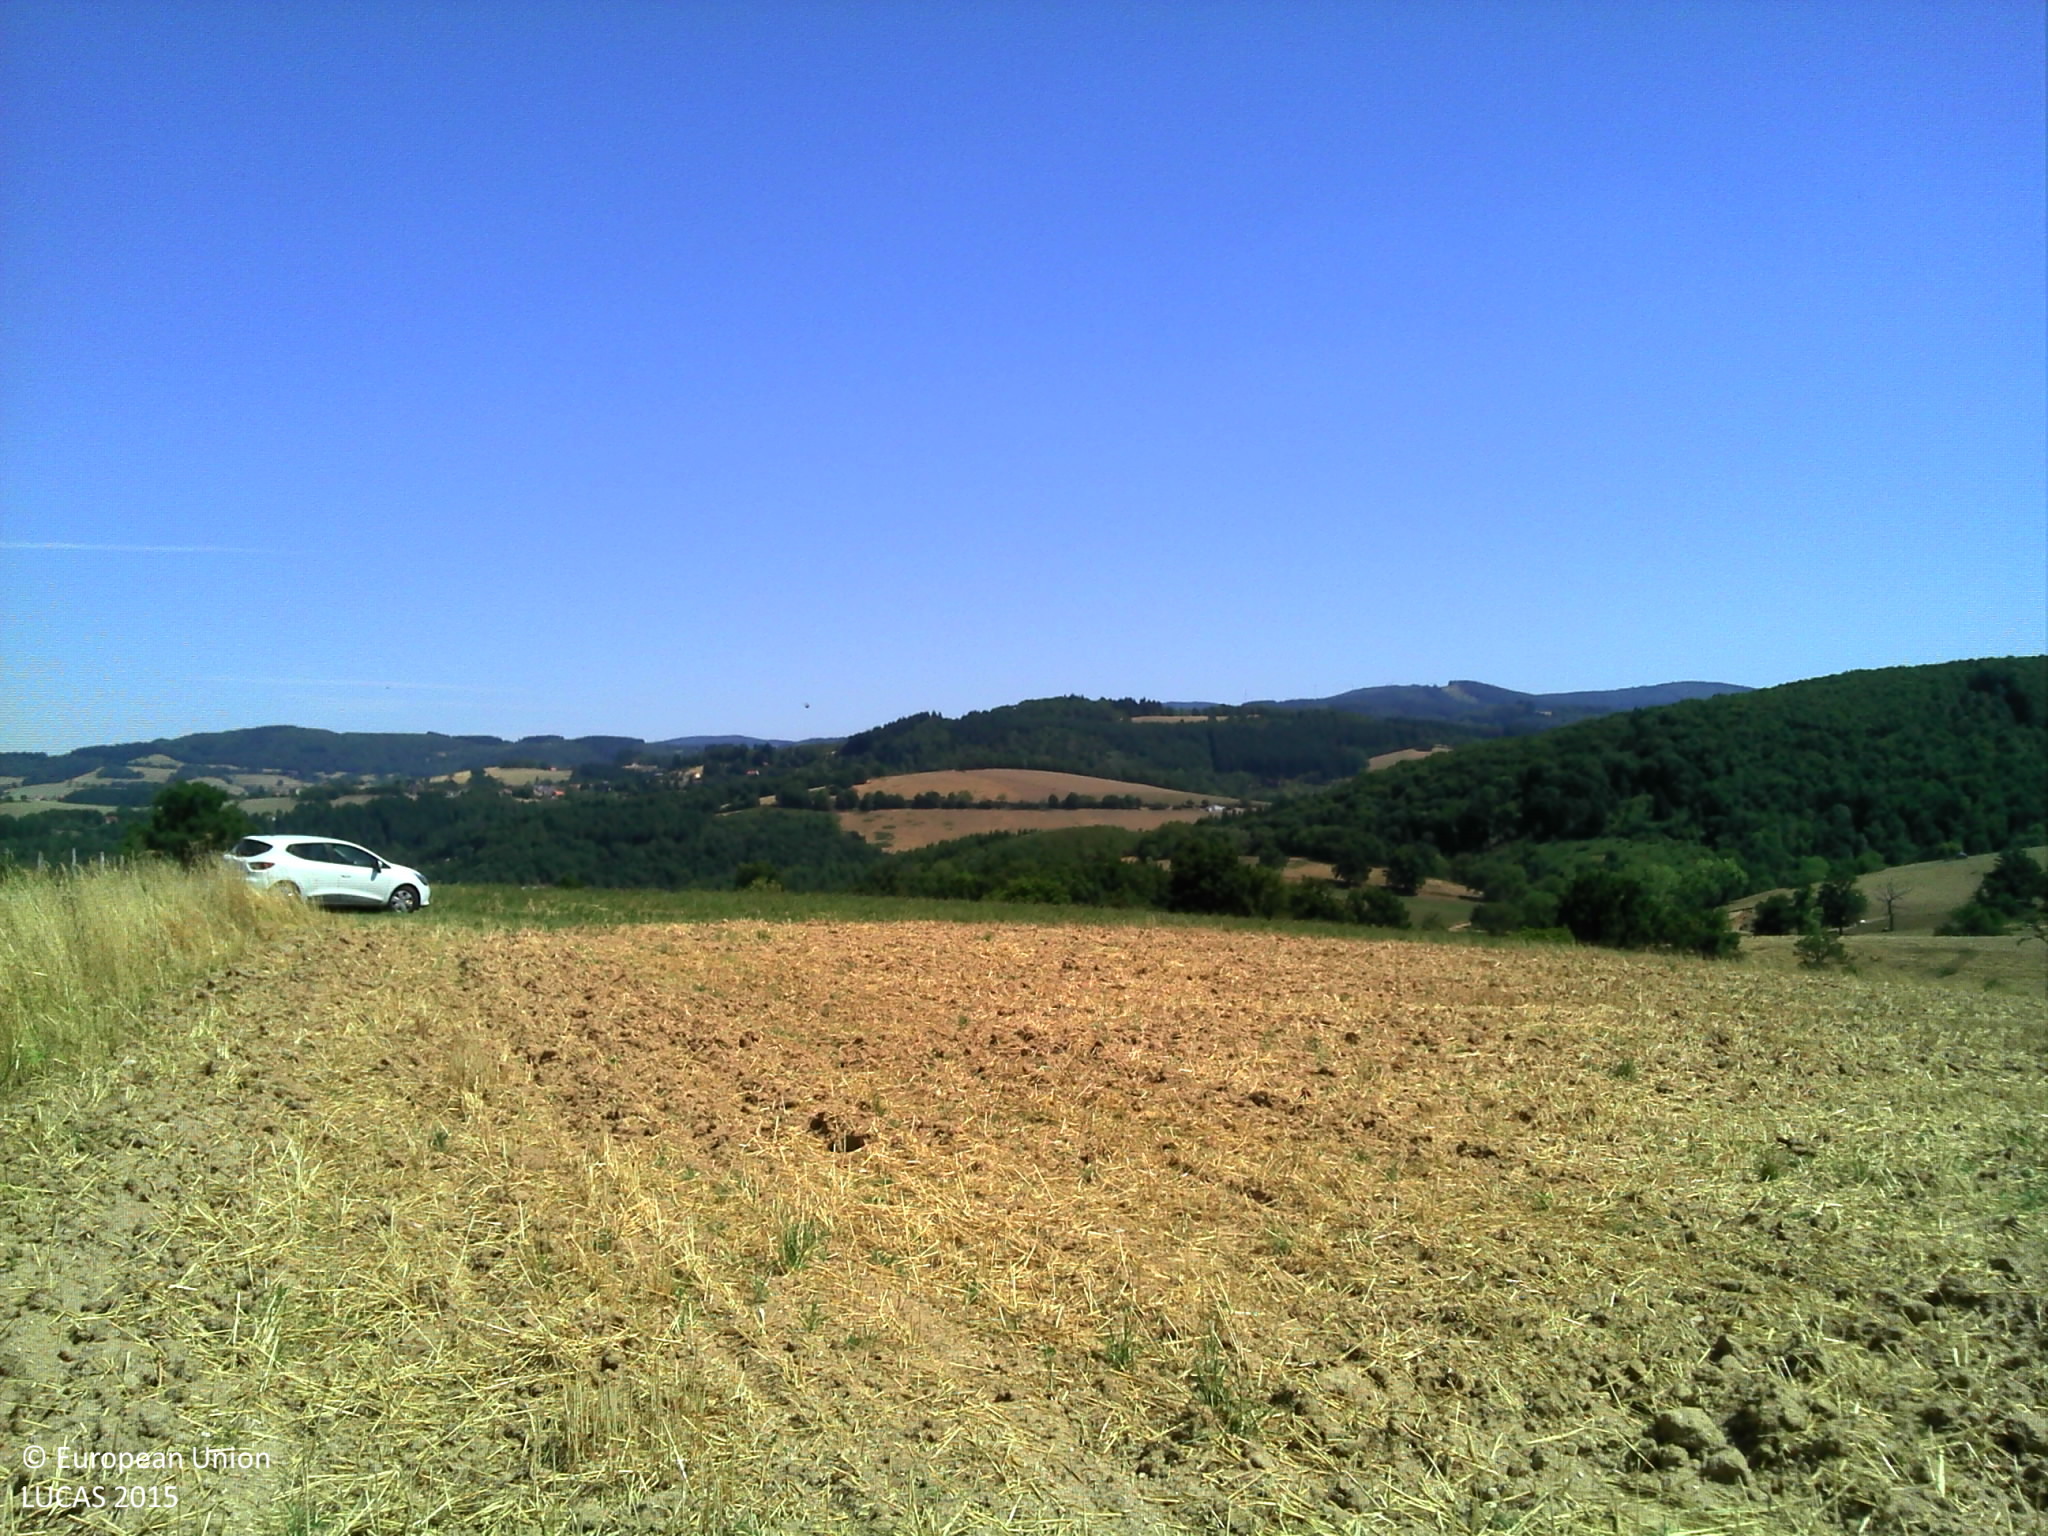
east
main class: Cropland
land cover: Triticale
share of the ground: 25 - 50 %
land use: Agriculture (excluding fallow land and kitchen gardens)
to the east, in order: Triticale; Clovers; Artificial constructions in urban areas
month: August
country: FR
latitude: 46.1082
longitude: 3.6480
